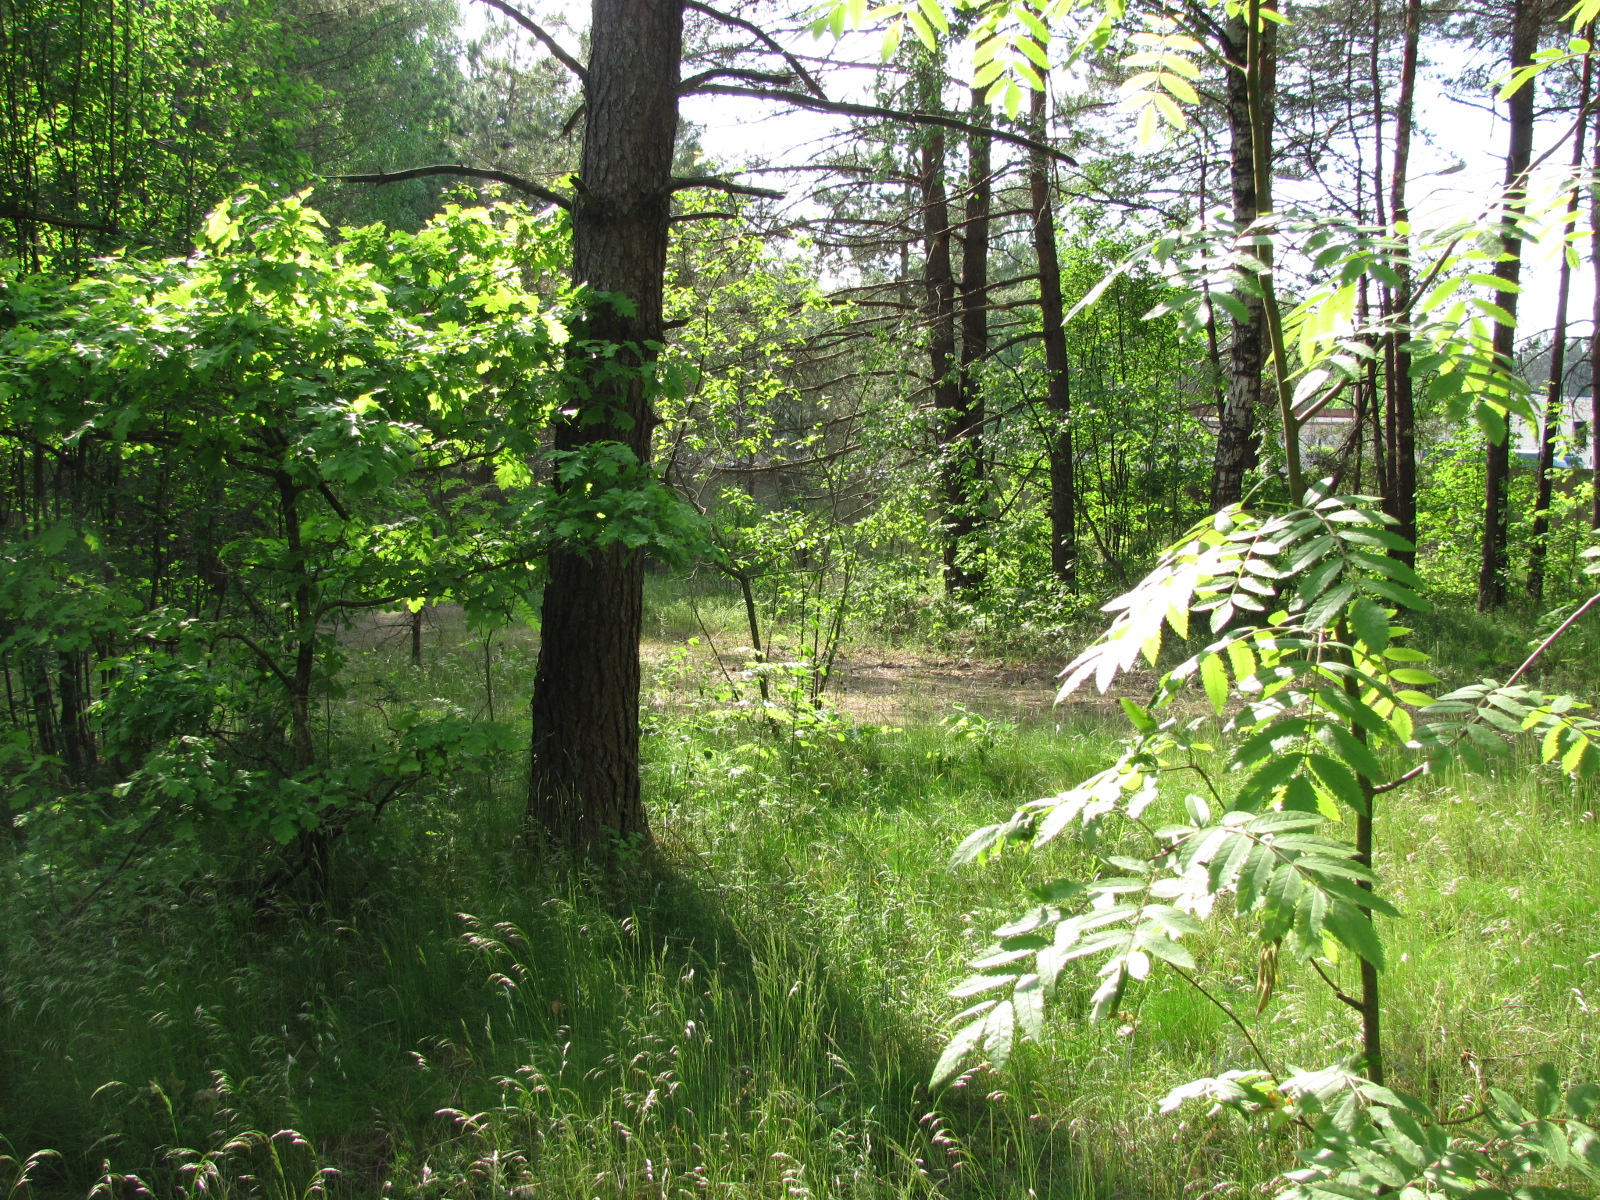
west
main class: Woodland
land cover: Pine dominated coniferous woodland
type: hemiboreal forest and nemoral coniferous forest and mixed broadleaved-coniferous forest
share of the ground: > 75 %
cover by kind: coniferous forest trees 75 %, herbaceous plants 25 %
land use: Forestry
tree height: > 5 m
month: June
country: LV
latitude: 56.9394
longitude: 24.2732
